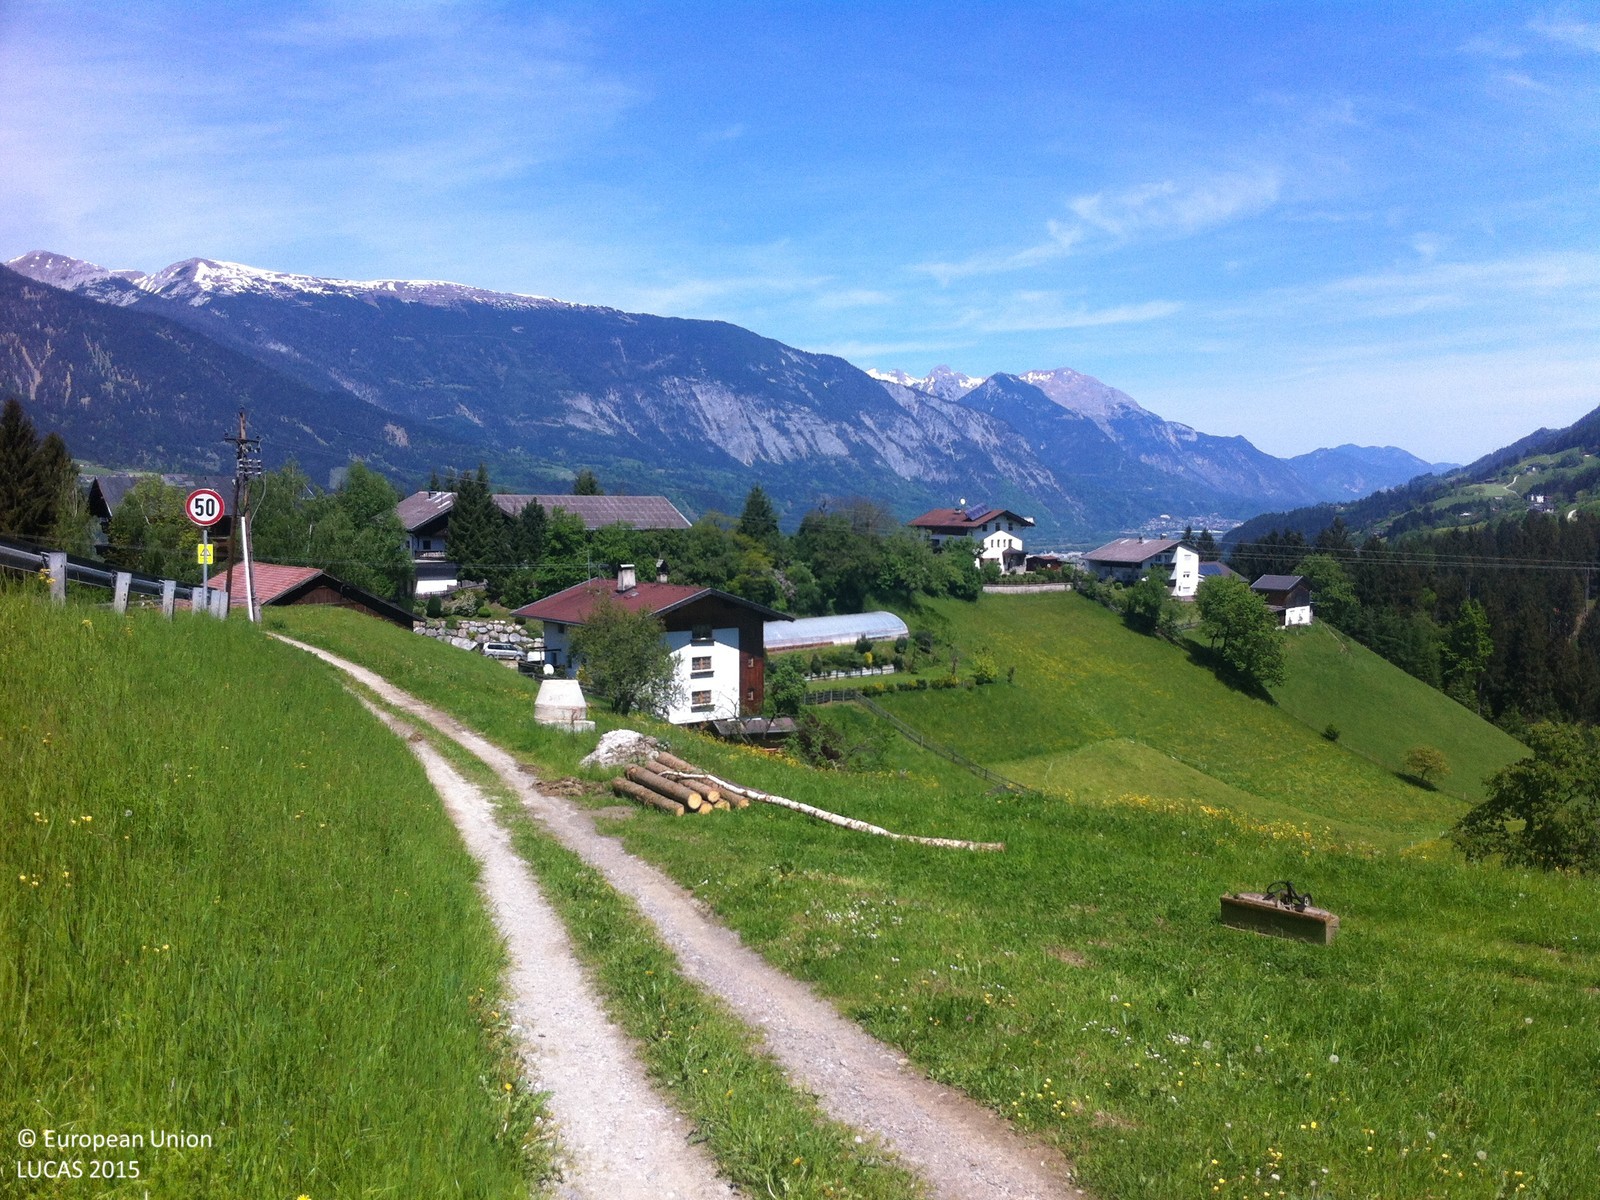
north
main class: Grassland
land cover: Grassland without tree/shrub cover
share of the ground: > 75 %
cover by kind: herbaceous plants 100 %
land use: Agriculture (excluding fallow land and kitchen gardens)
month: May
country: AT
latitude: 47.3106
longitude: 11.6785
